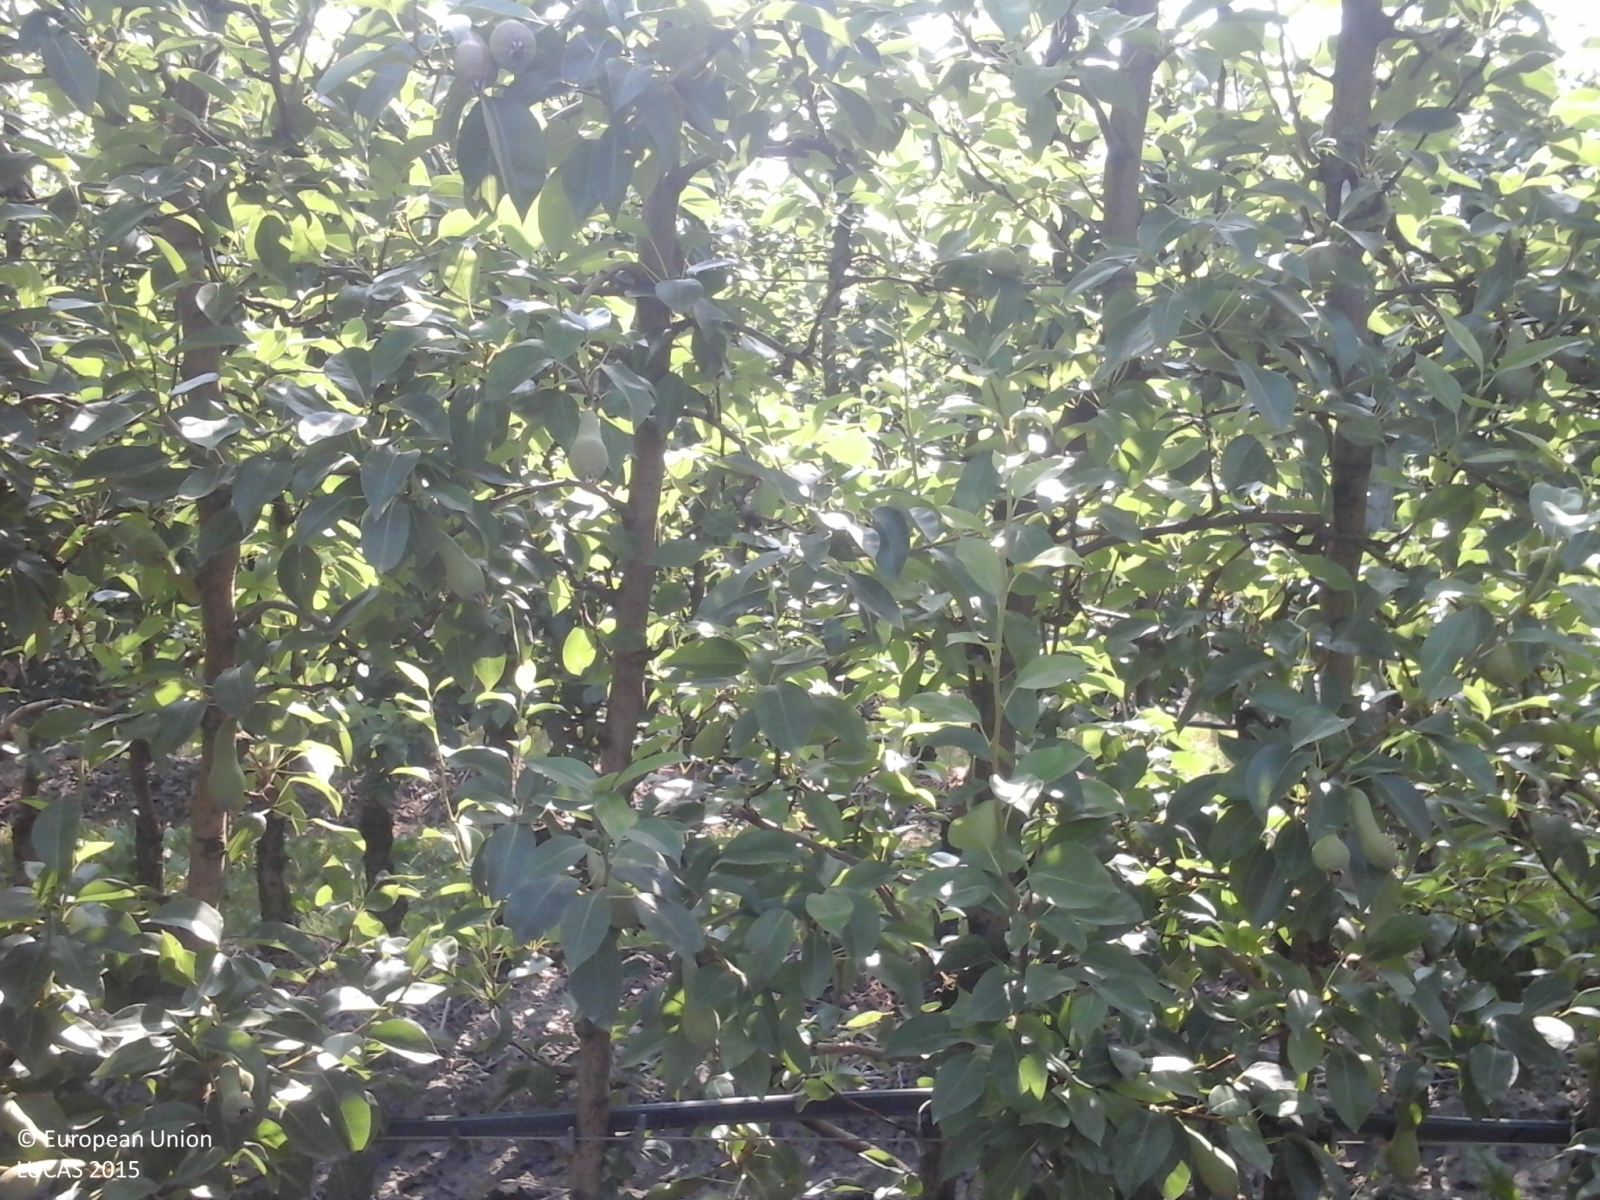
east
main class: Cropland
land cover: Pear fruit
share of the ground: 50 - 75 %
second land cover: Grassland without tree/shrub cover
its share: 50 - 75 %
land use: Agriculture (excluding fallow land and kitchen gardens)
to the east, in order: Pear fruit; Grassland without tree/shrub cover; Electric lines; Pear fruit; Electric lines; Pear fruit; Paved roads, cycling and walking lanes; Grass margins; Paved roads, cycling and walking lanes; Inland fresh running water; Artificial constructions in urban areas; Inland fresh running water; Tracks; Common wheat
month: May
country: IT
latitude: 44.8420
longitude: 11.6793
